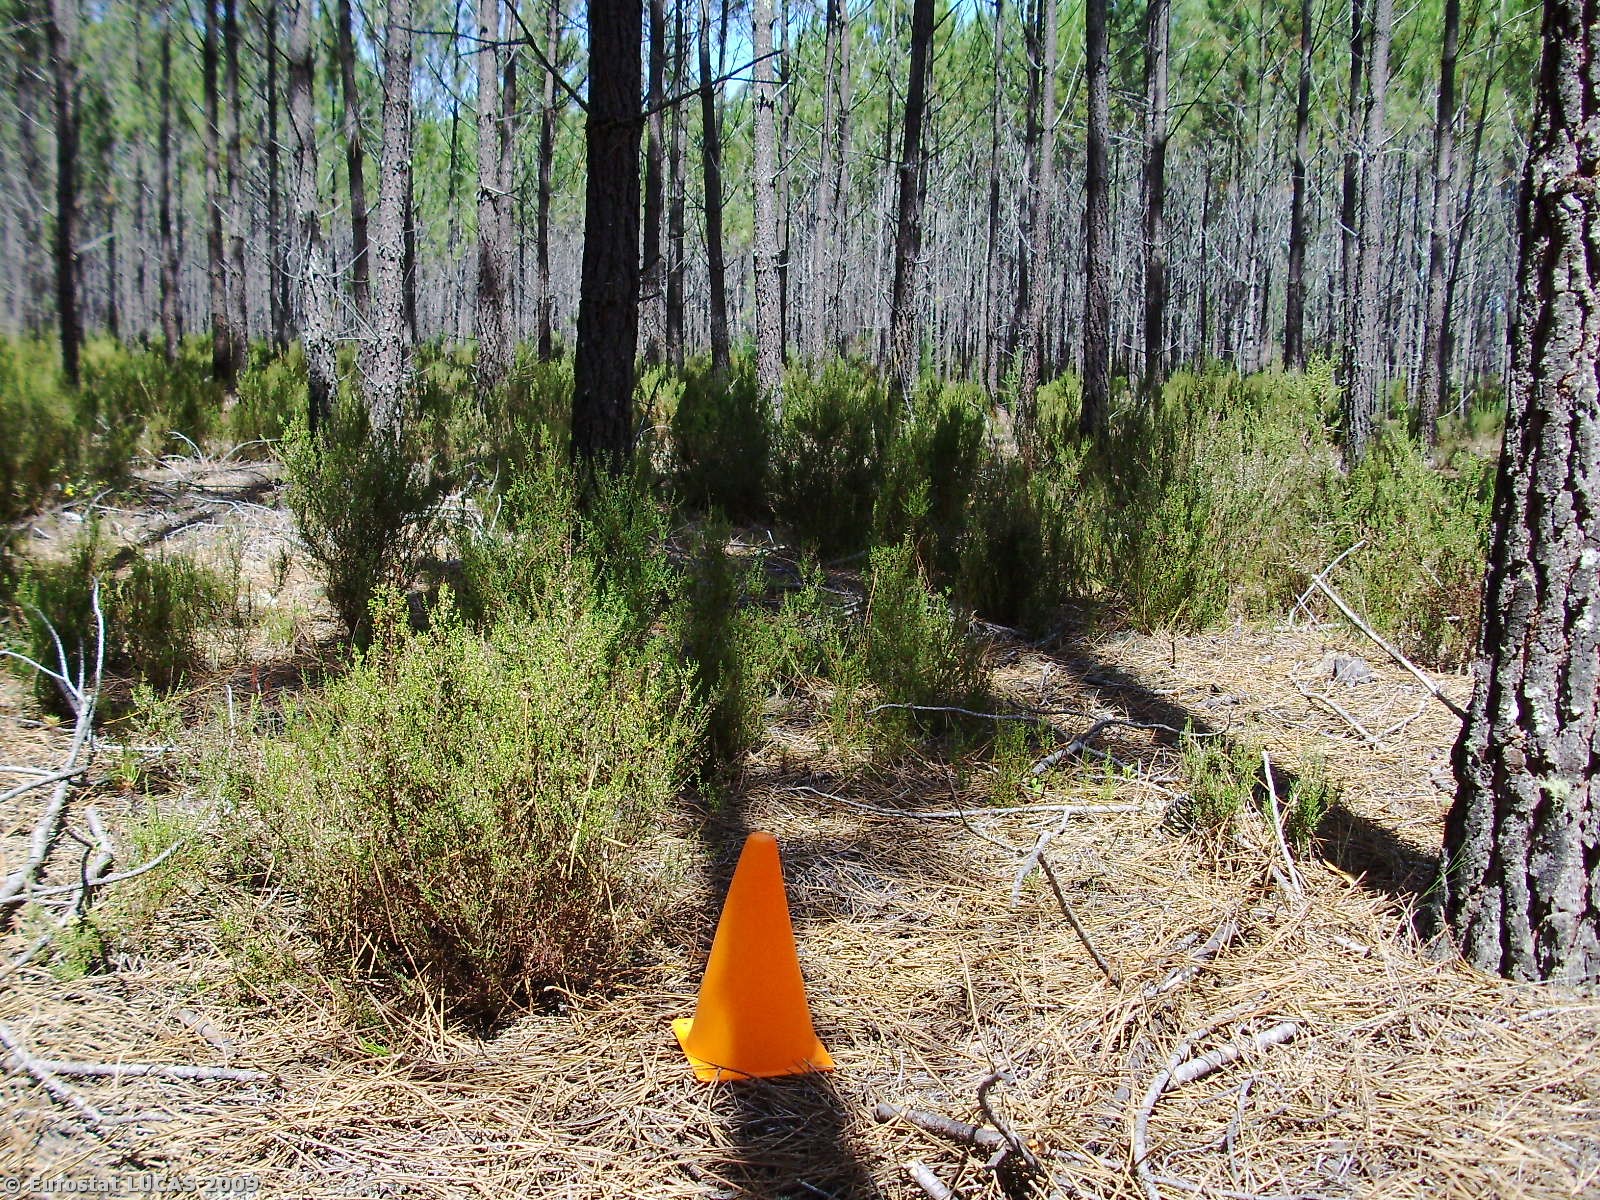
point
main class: Woodland
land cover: Coniferous woodland
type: coniferous forest of the mediterranean region
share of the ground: > 75 %
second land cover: Shrubland with sparse tree cover
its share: 10 - 25 %
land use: Forestry
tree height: > 5 m
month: July
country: PT
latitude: 39.7818
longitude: -8.8996
